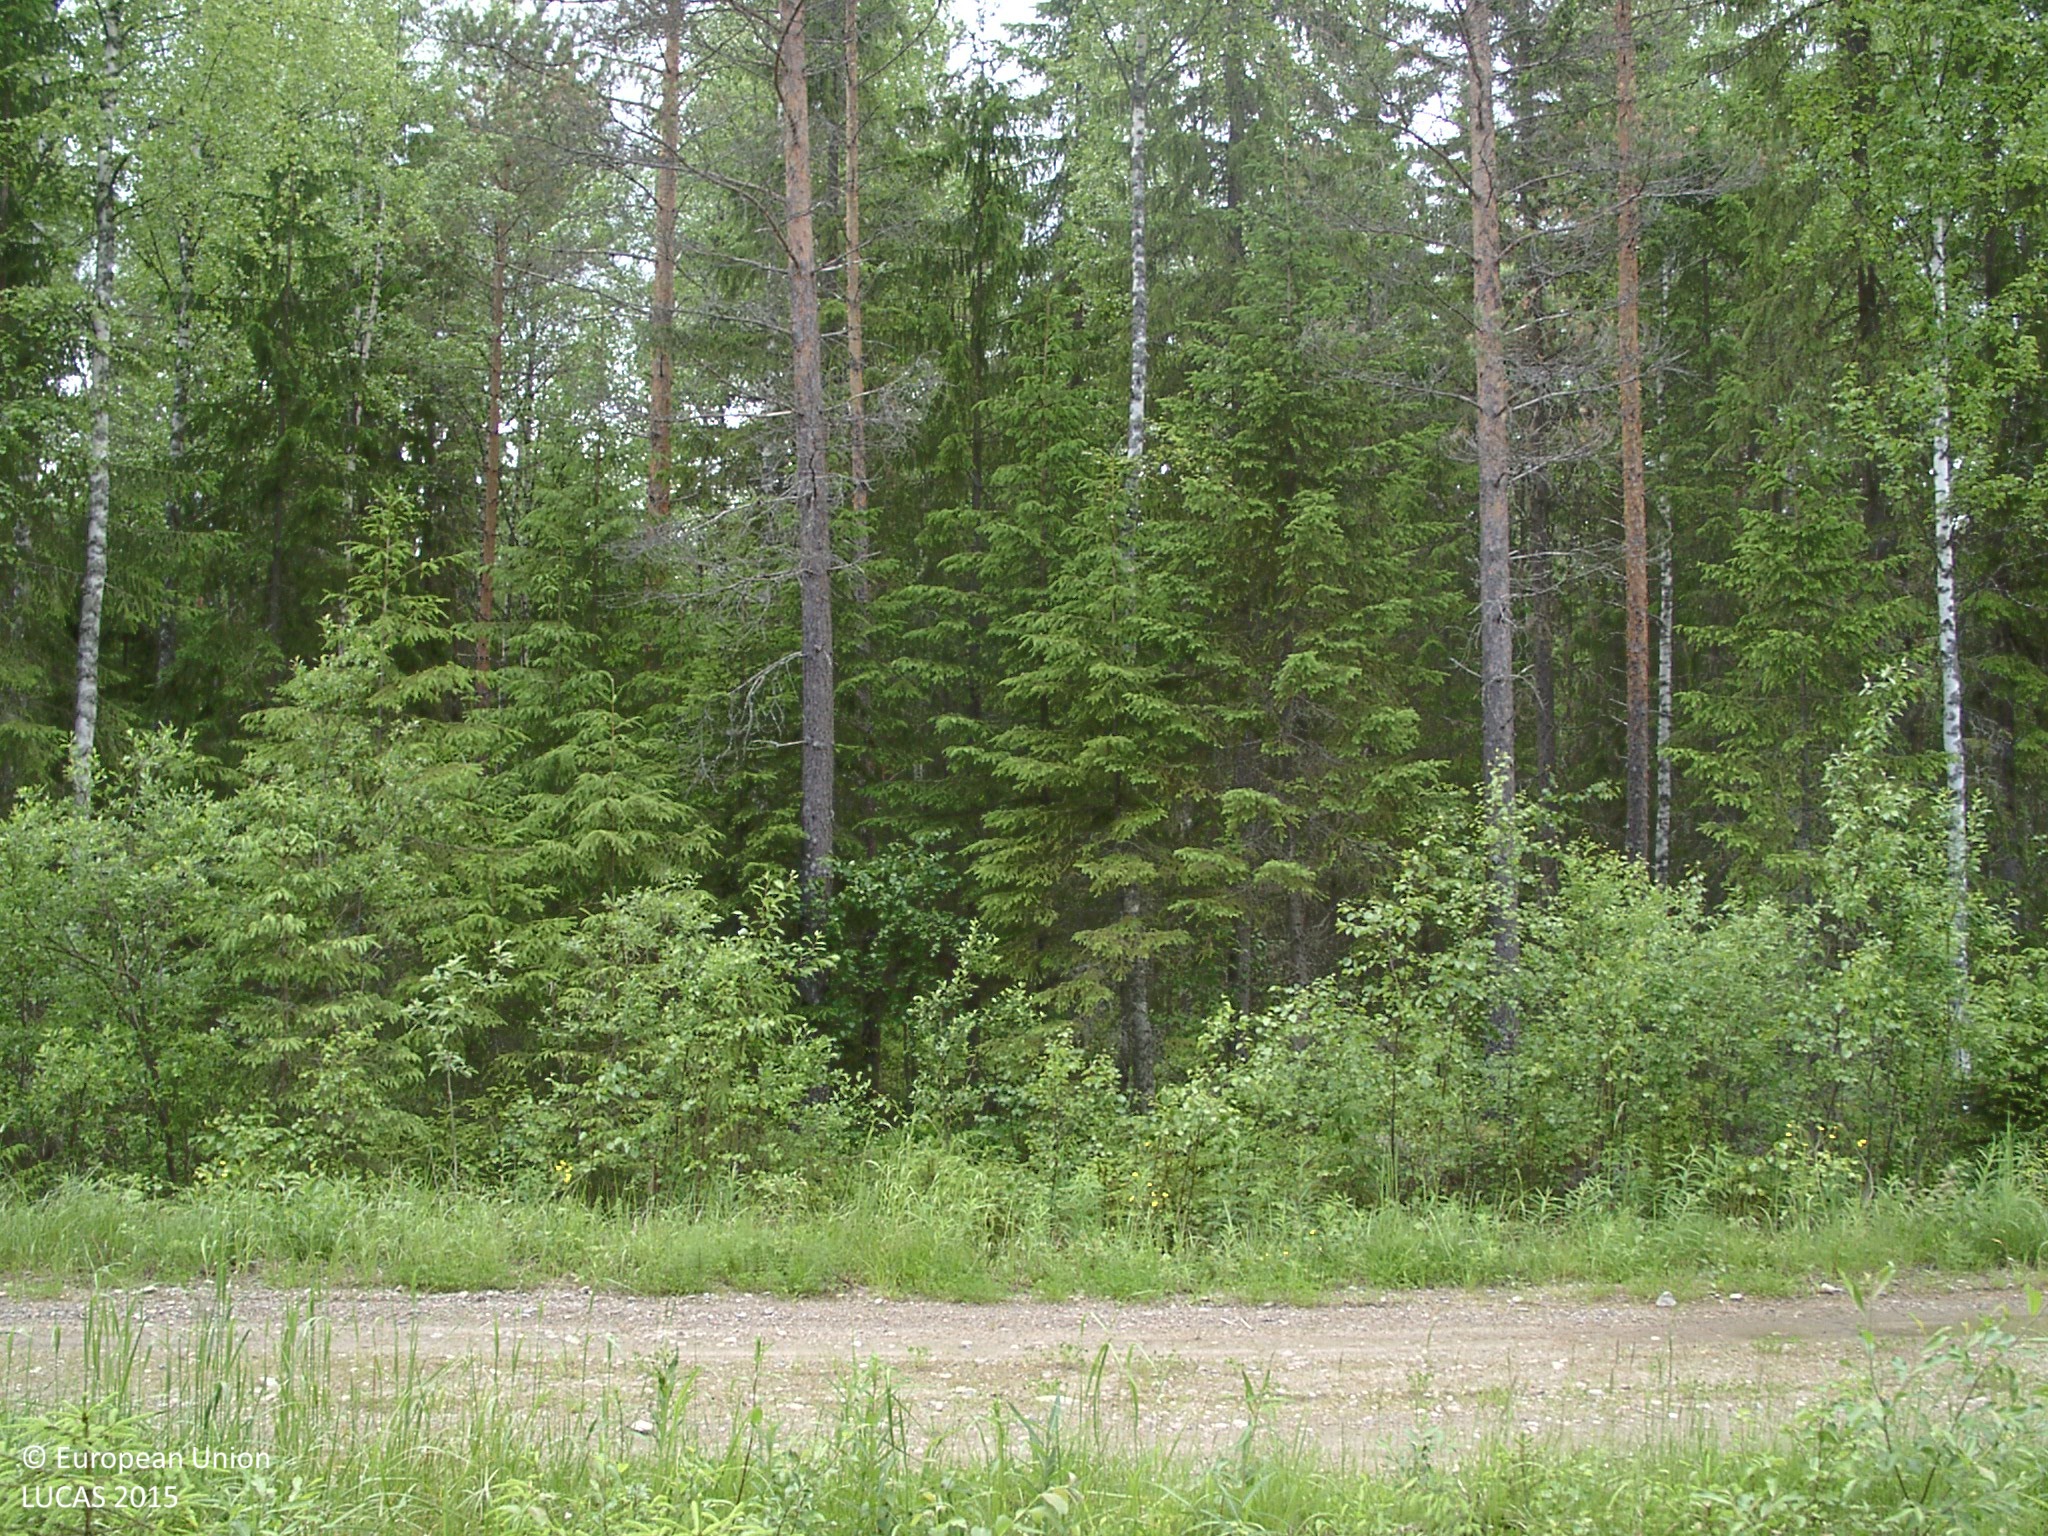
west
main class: Woodland
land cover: Other coniferous woodland
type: boreal forest
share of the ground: > 75 %
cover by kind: coniferous forest trees 70 %, shrubs 15 %, broadleaved forest trees 10 %, lichens and mosses 5 %
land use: Semi-natural and natural areas not in use
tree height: > 5 m
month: June
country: FI
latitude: 61.9213
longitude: 24.7066
